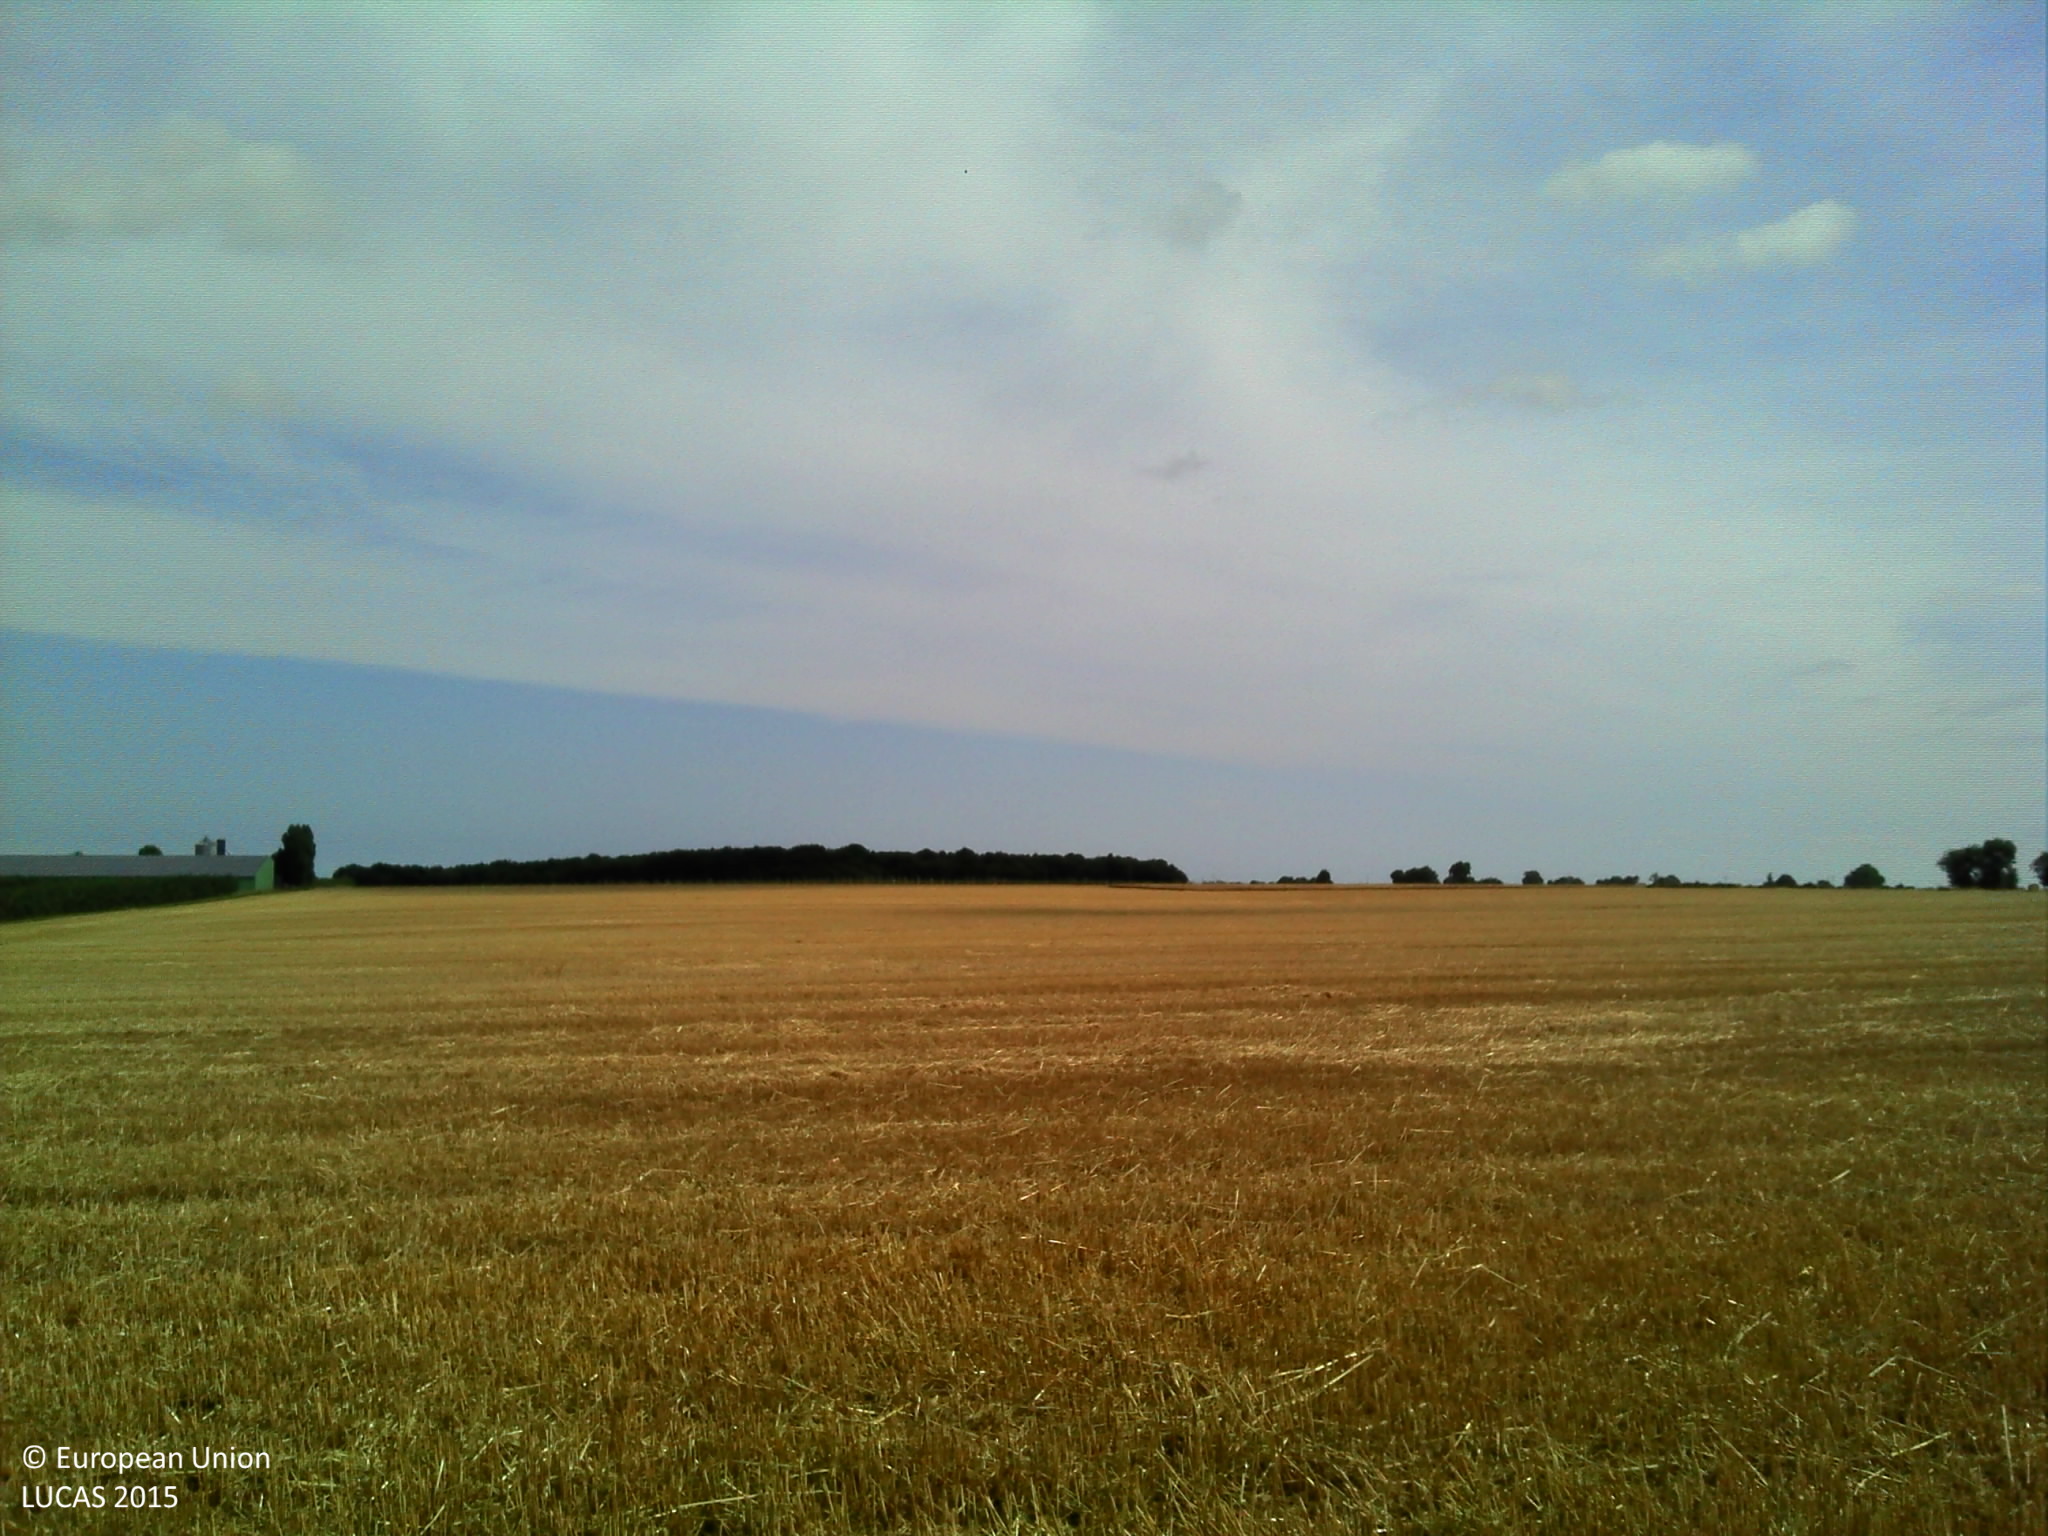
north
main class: Cropland
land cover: Common wheat
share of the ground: > 75 %
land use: Agriculture (excluding fallow land and kitchen gardens)
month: July
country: FR
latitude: 47.8603
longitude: 0.6351
